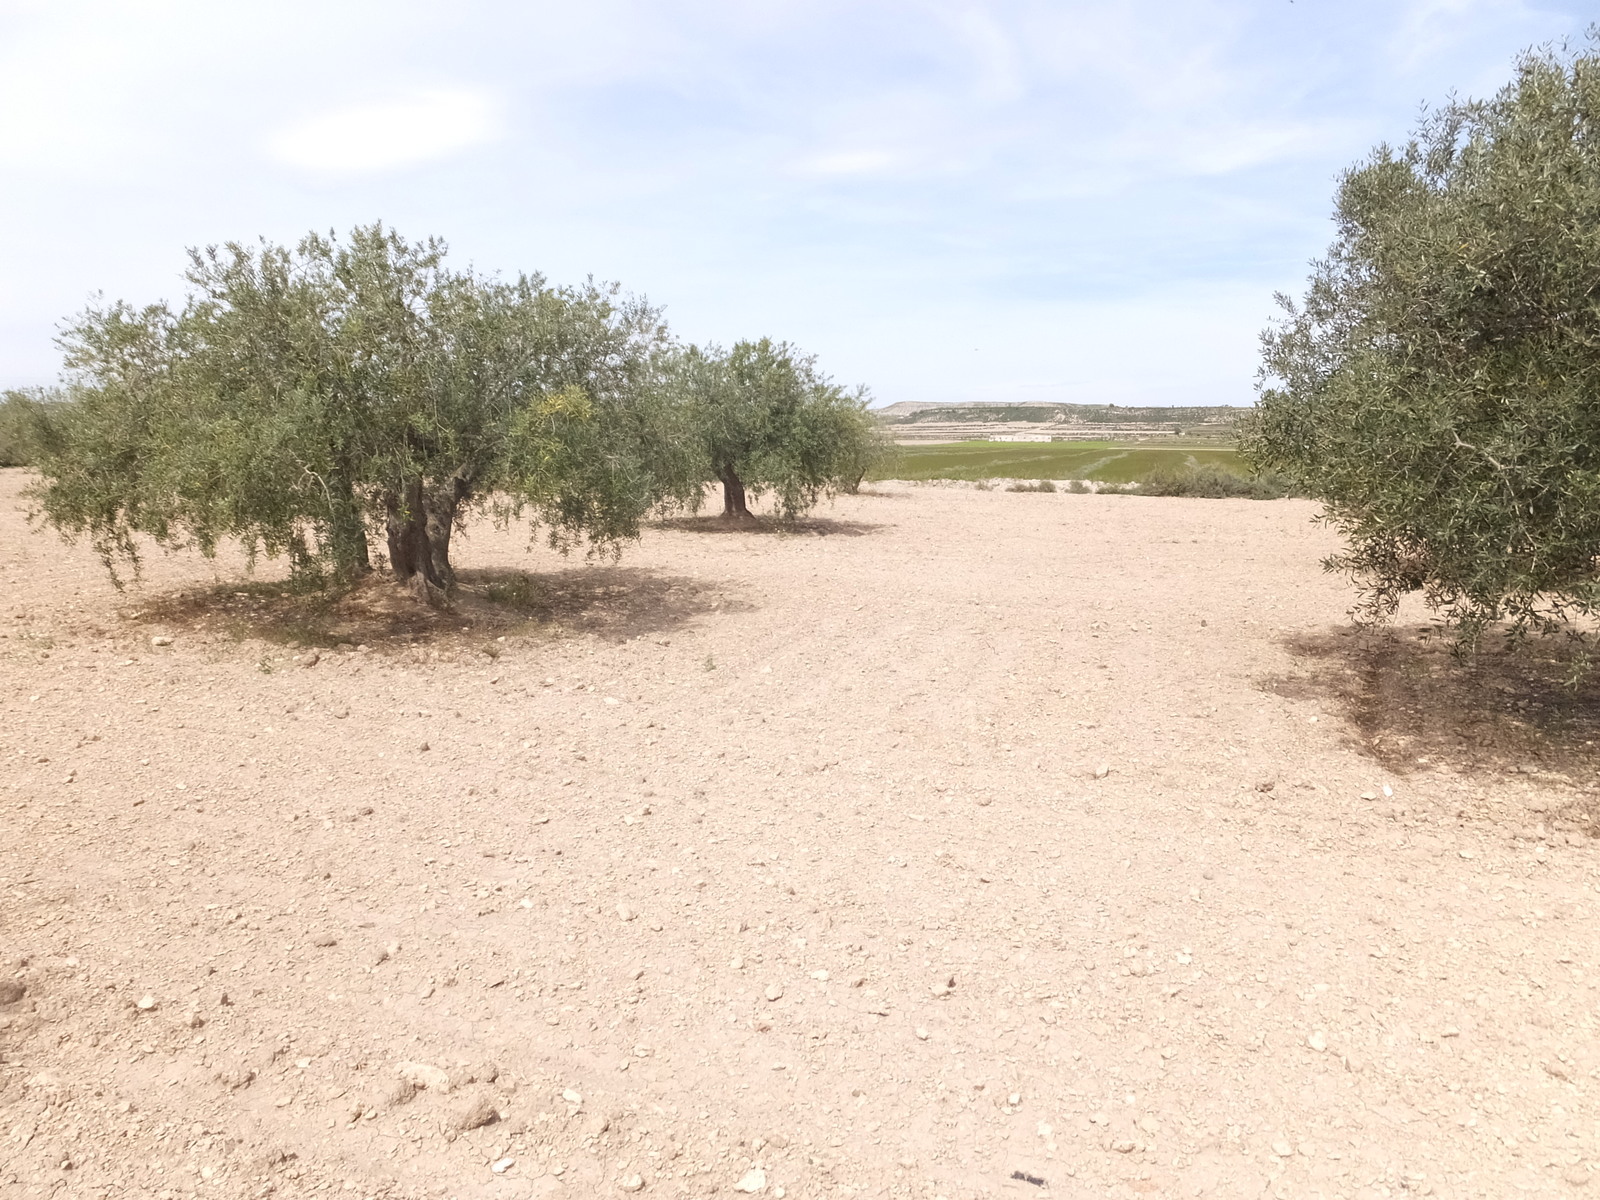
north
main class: Cropland
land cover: Olive groves
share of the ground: 10 - 25 %
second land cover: Other bare soil
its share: > 75 %
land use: Agriculture (excluding fallow land and kitchen gardens)
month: April
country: ES
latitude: 41.5918
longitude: -0.2015
